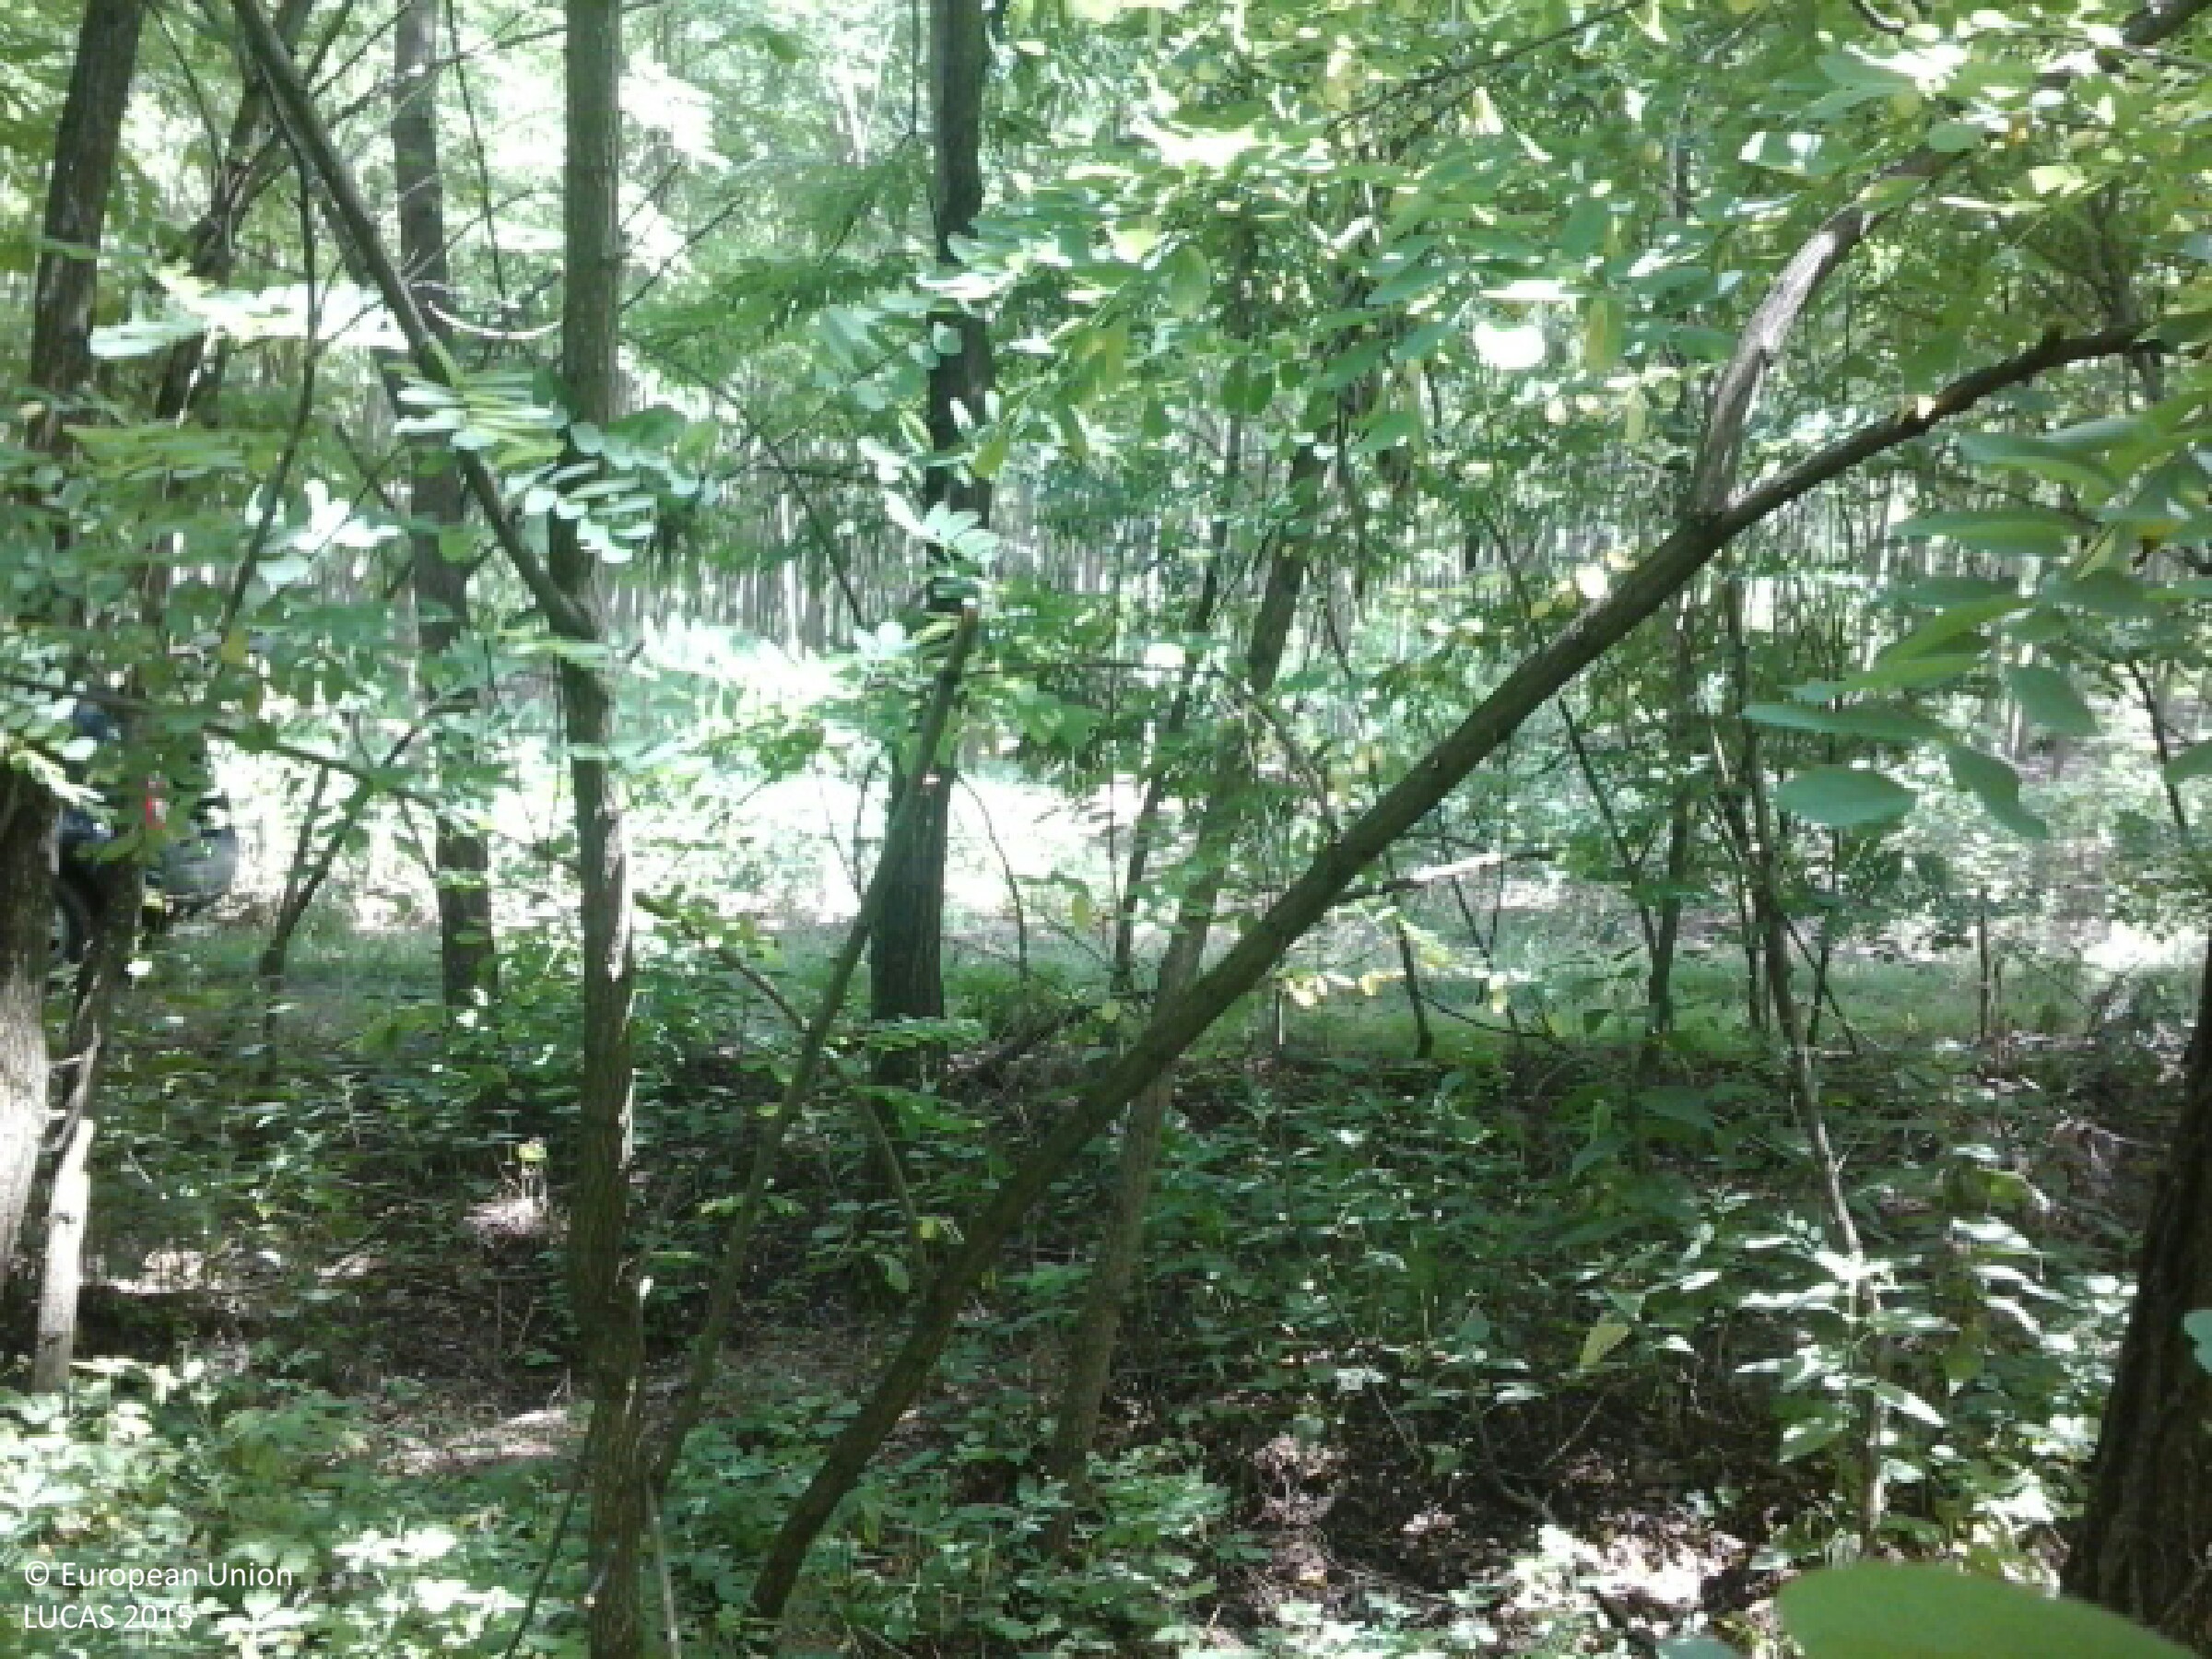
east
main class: Woodland
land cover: Broadleaved woodland
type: mesophytic deciduous forest
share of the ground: > 75 %
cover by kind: broadleaved forest trees 95 %, herbaceous plants 5 %
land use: Forestry
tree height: > 5 m
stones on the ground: < 10 %
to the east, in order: Broadleaved woodland; Tracks; Broadleaved woodland
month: June
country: HU
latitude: 48.1119
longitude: 22.1567
